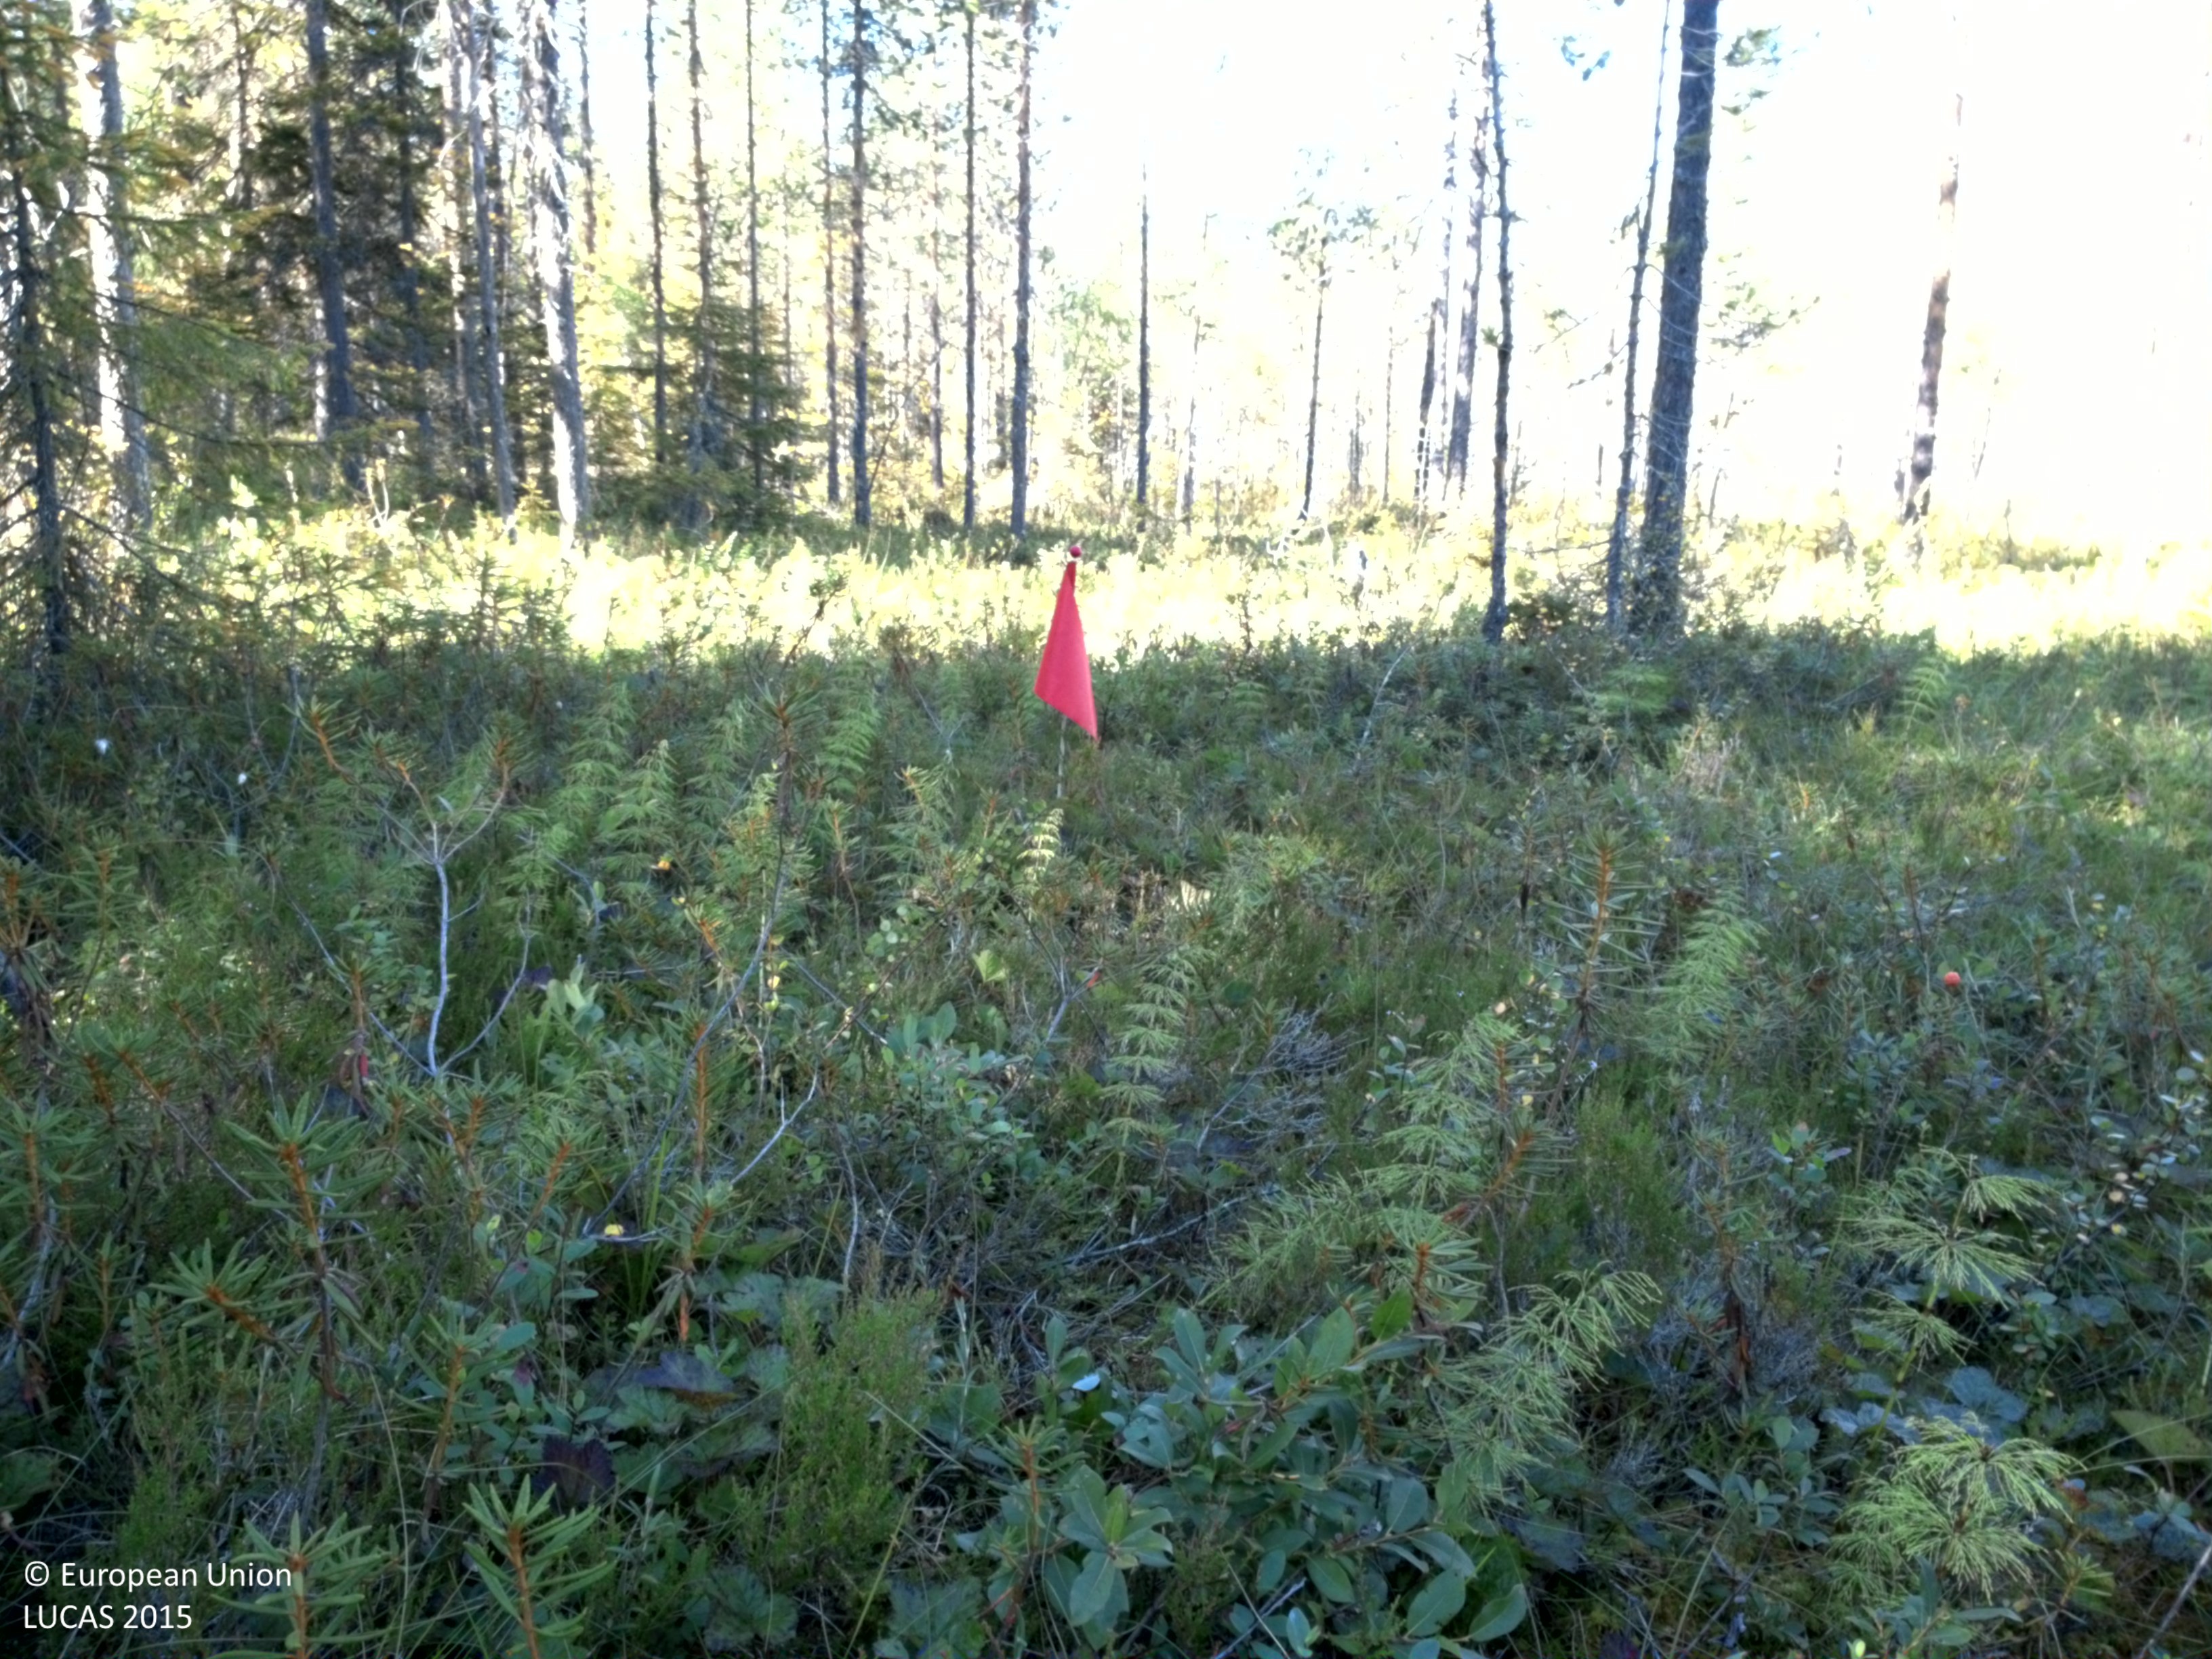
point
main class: Woodland
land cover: Pine dominated coniferous woodland
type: boreal forest
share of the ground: 25 - 50 %
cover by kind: shrubs 65 %, coniferous forest trees 30 %, lichens and mosses 5 %
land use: Forestry
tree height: > 5 m
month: August
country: SE
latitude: 66.1136
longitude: 22.6153
